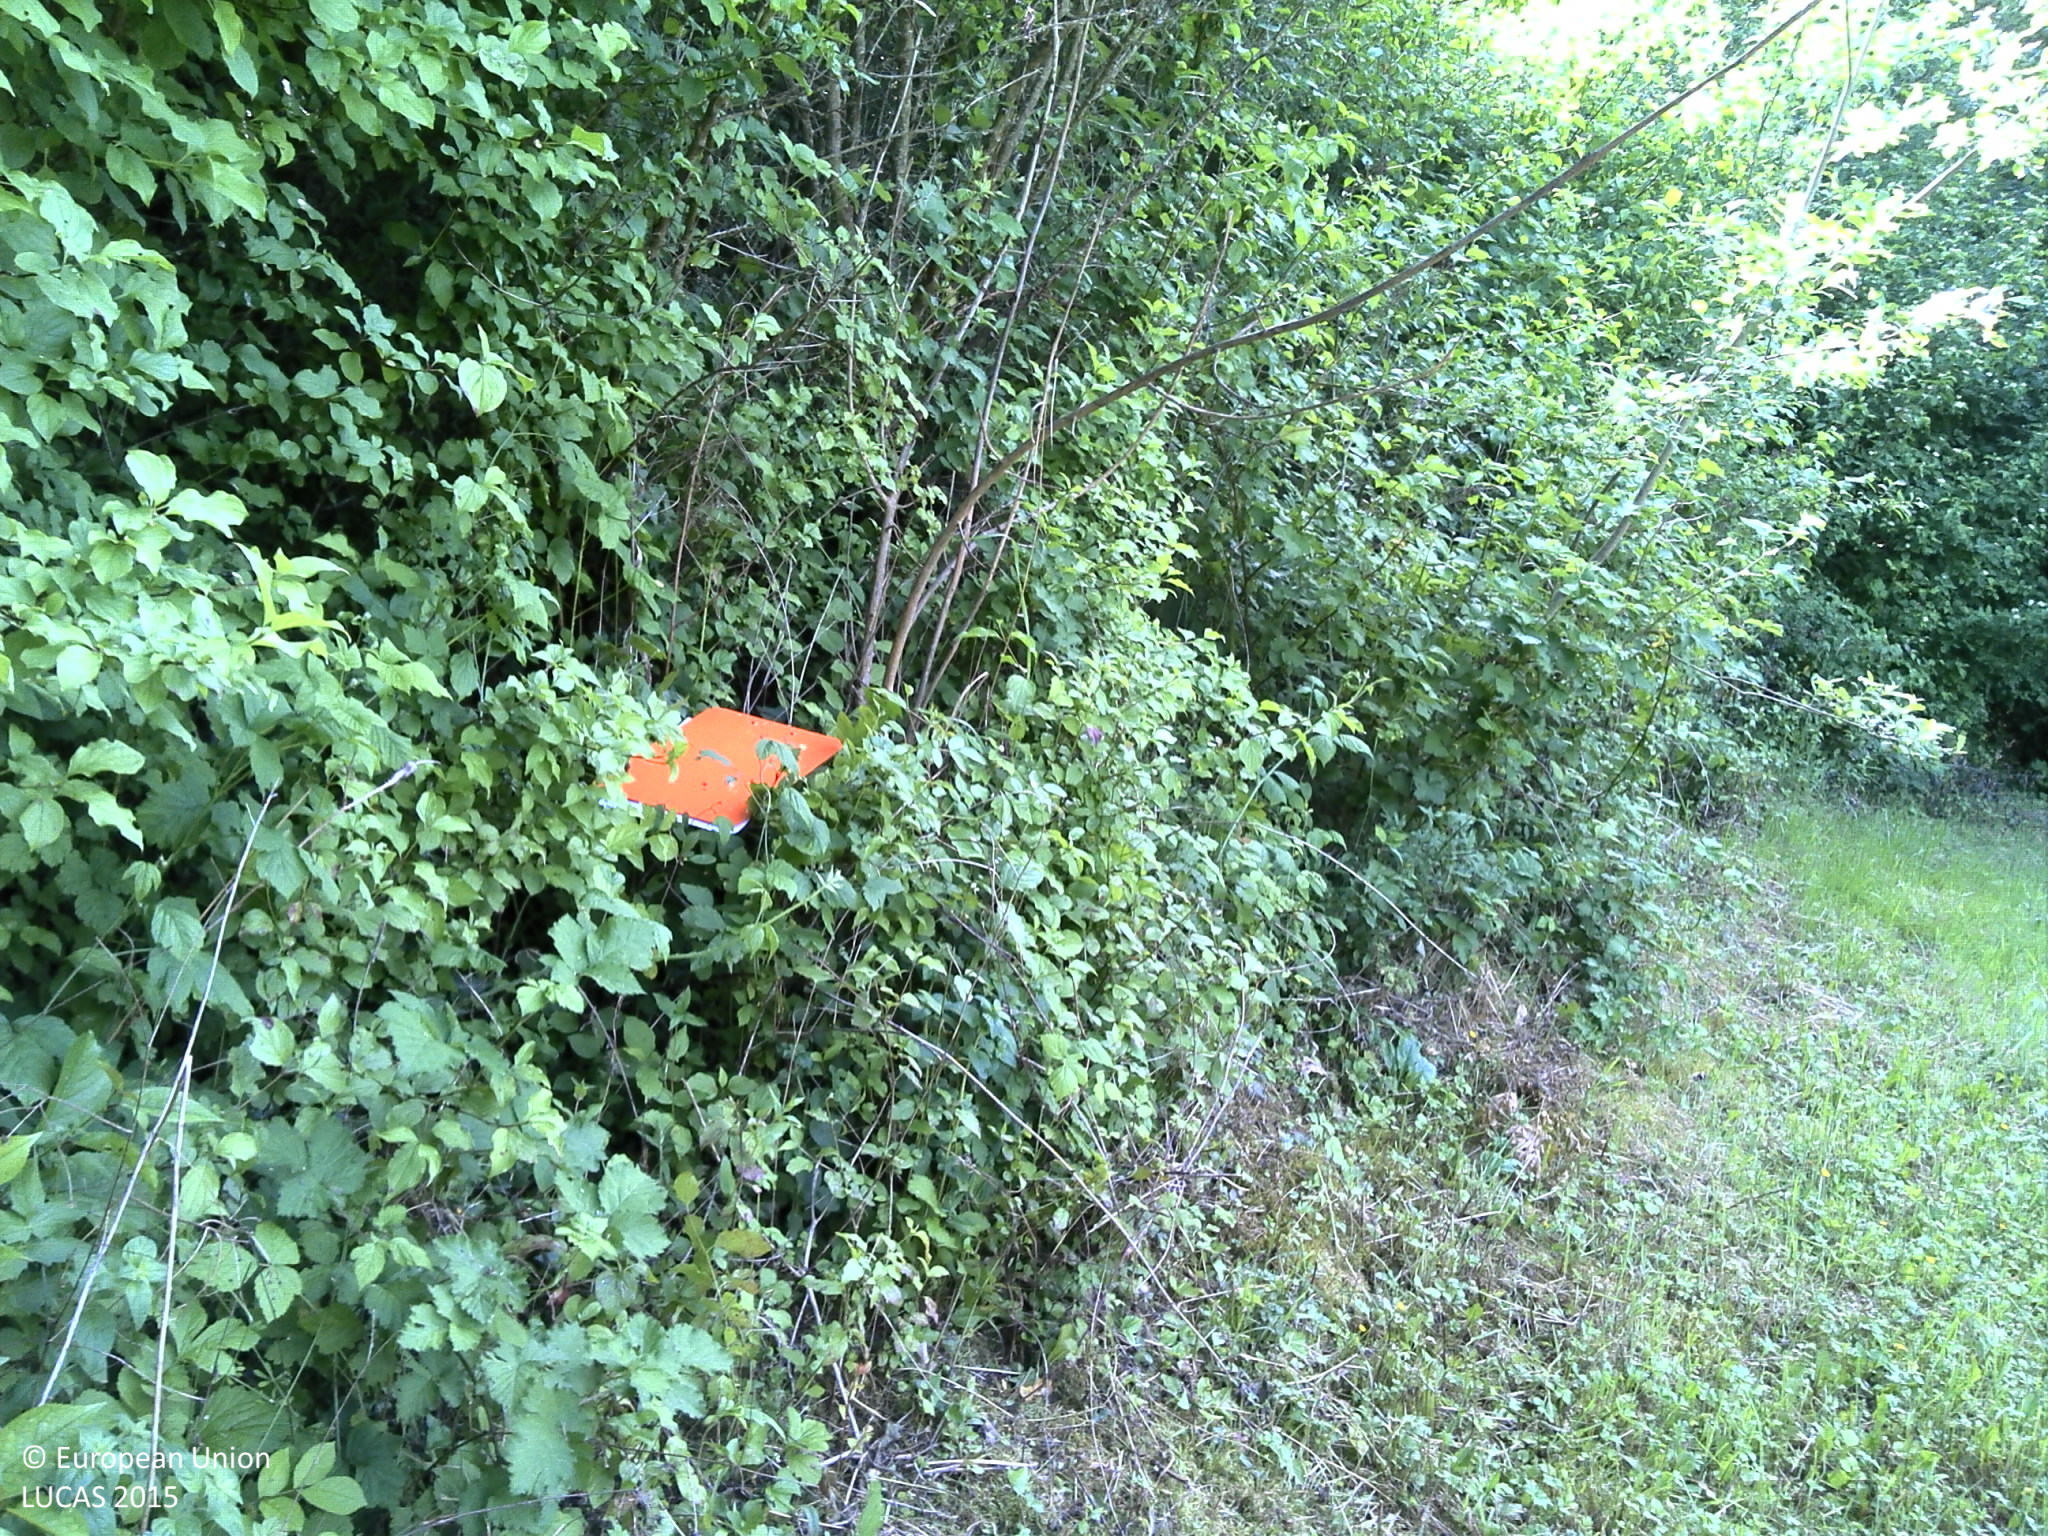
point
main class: Grassland
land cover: Grassland without tree/shrub cover
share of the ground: > 75 %
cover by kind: herbaceous plants 100 %
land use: Agriculture (excluding fallow land and kitchen gardens)
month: June
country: FR
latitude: 49.0363
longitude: 6.0738
